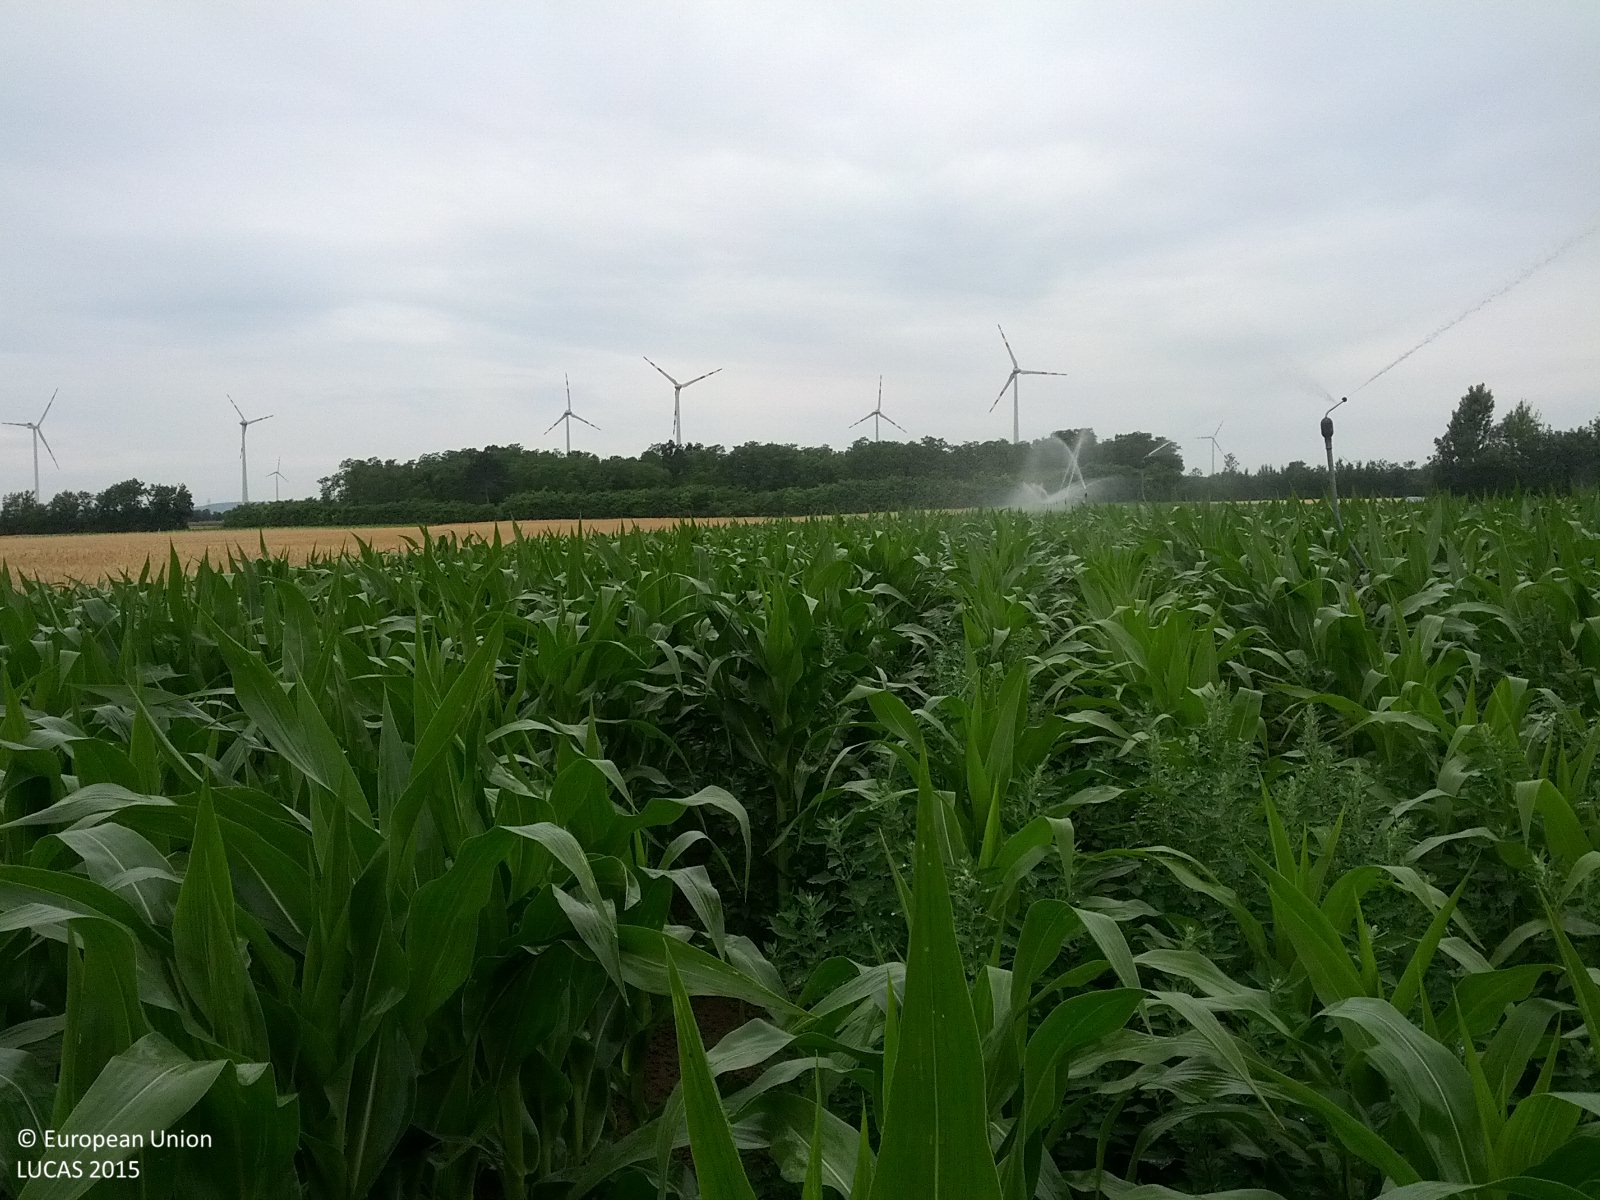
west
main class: Cropland
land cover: Maize
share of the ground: > 75 %
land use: Agriculture (excluding fallow land and kitchen gardens)
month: June
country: AT
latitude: 48.3341
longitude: 16.5755
